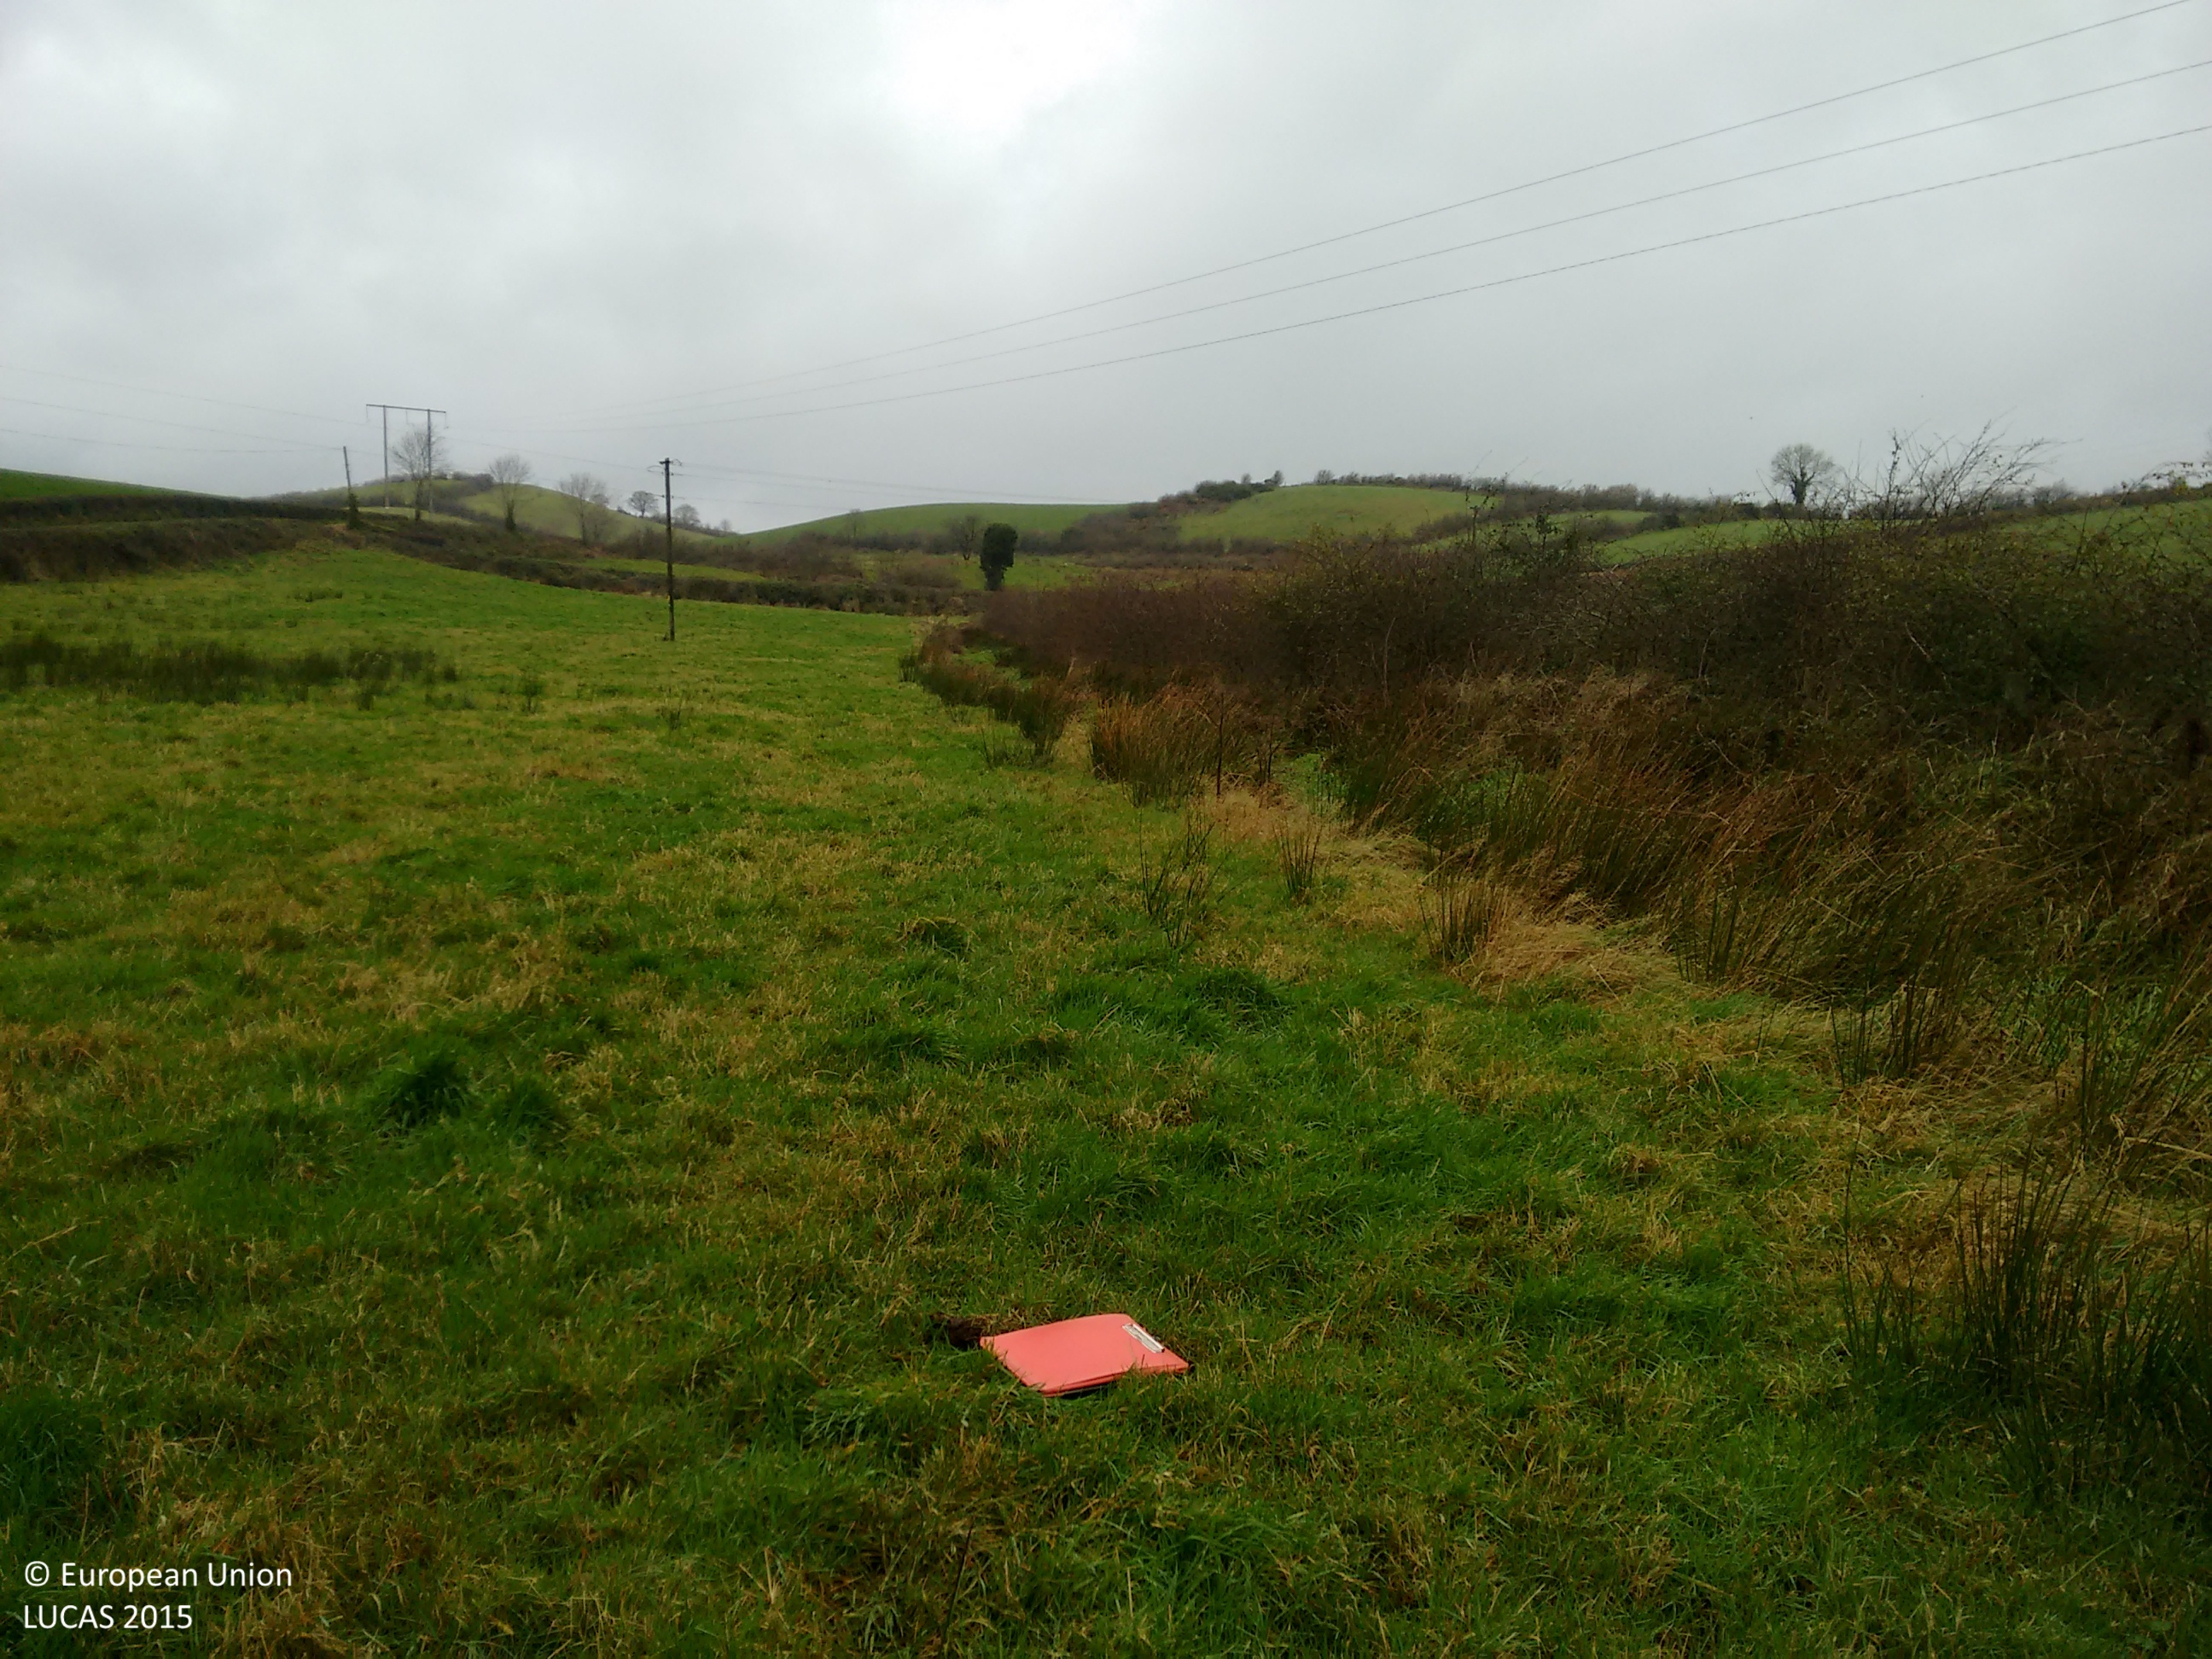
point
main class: Grassland
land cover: Grassland without tree/shrub cover
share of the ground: > 75 %
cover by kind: herbaceous plants 100 %
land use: Agriculture (excluding fallow land and kitchen gardens)
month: December
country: IE
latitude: 54.0212
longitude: -6.9126
